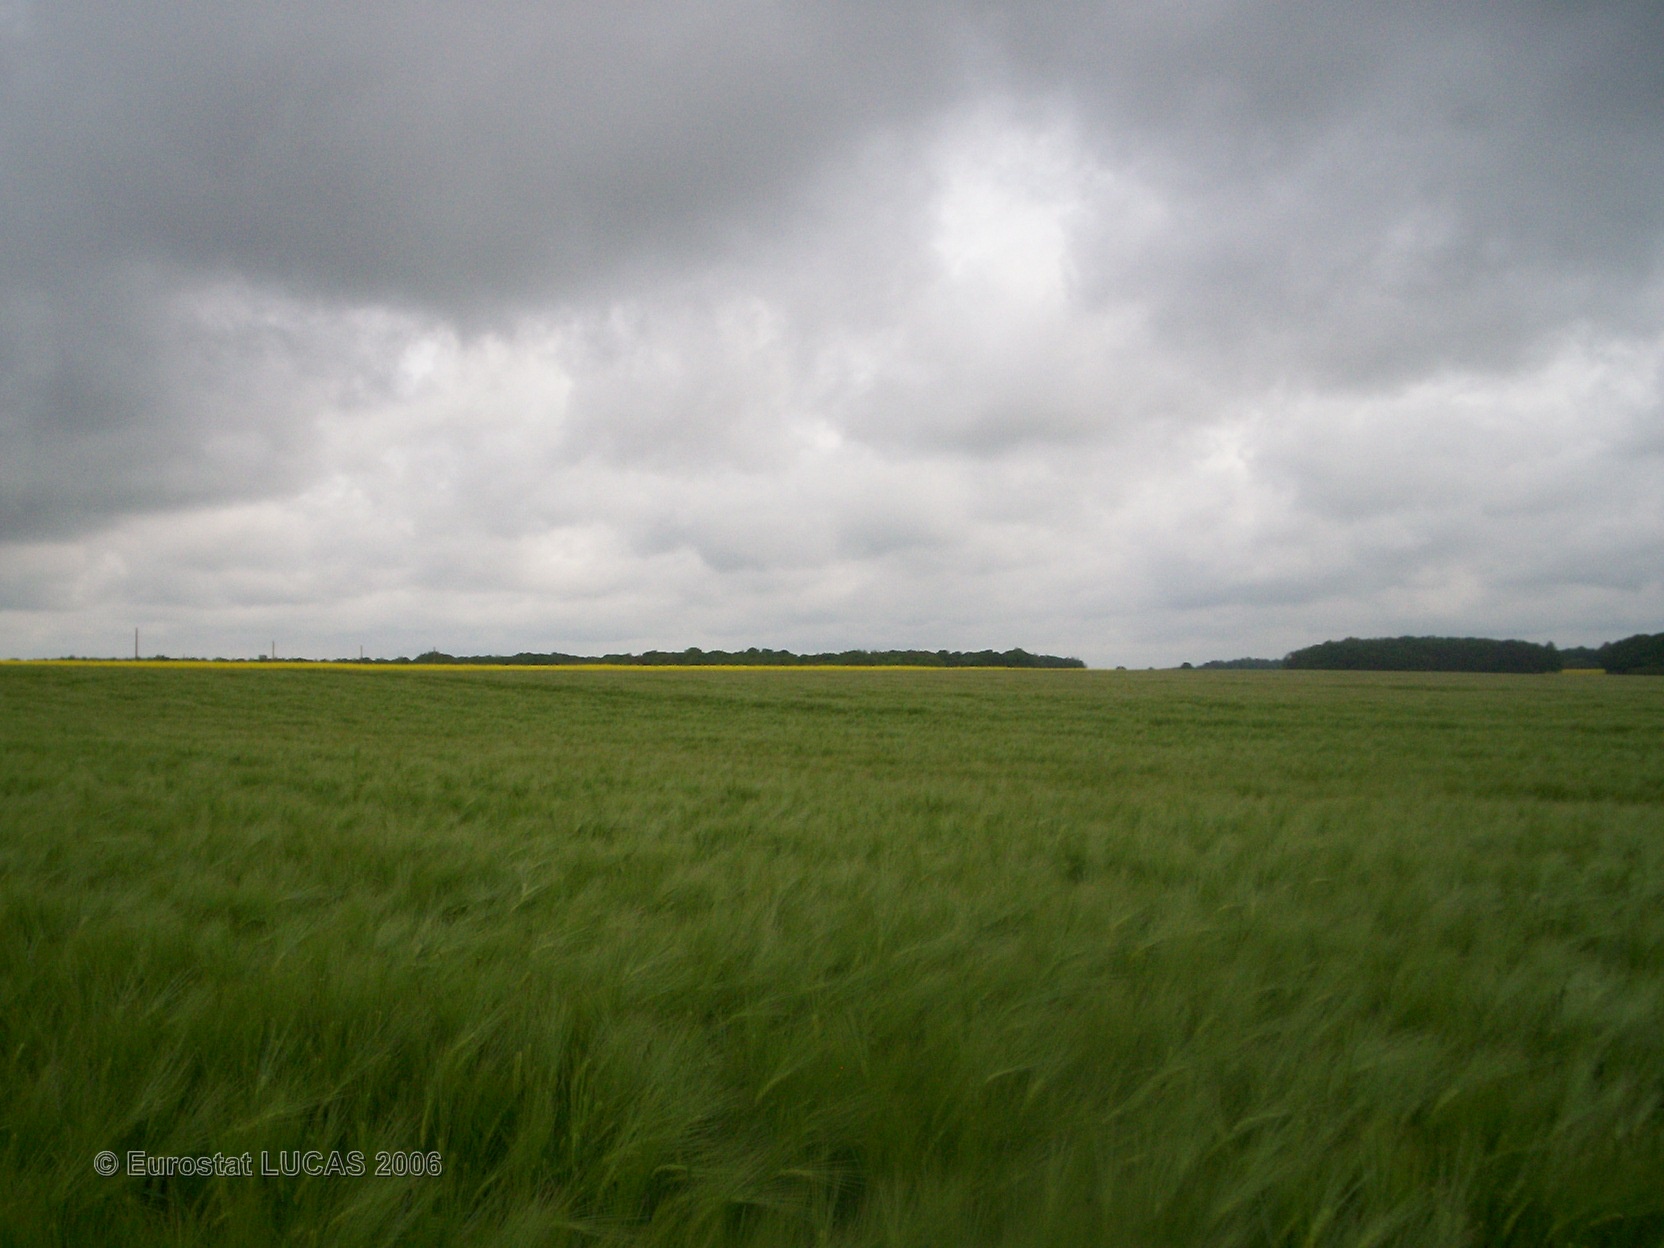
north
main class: Cropland
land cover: Barley
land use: Agriculture (excluding fallow land and kitchen gardens)
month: May
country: FR
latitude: 47.9785
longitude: 2.9324
